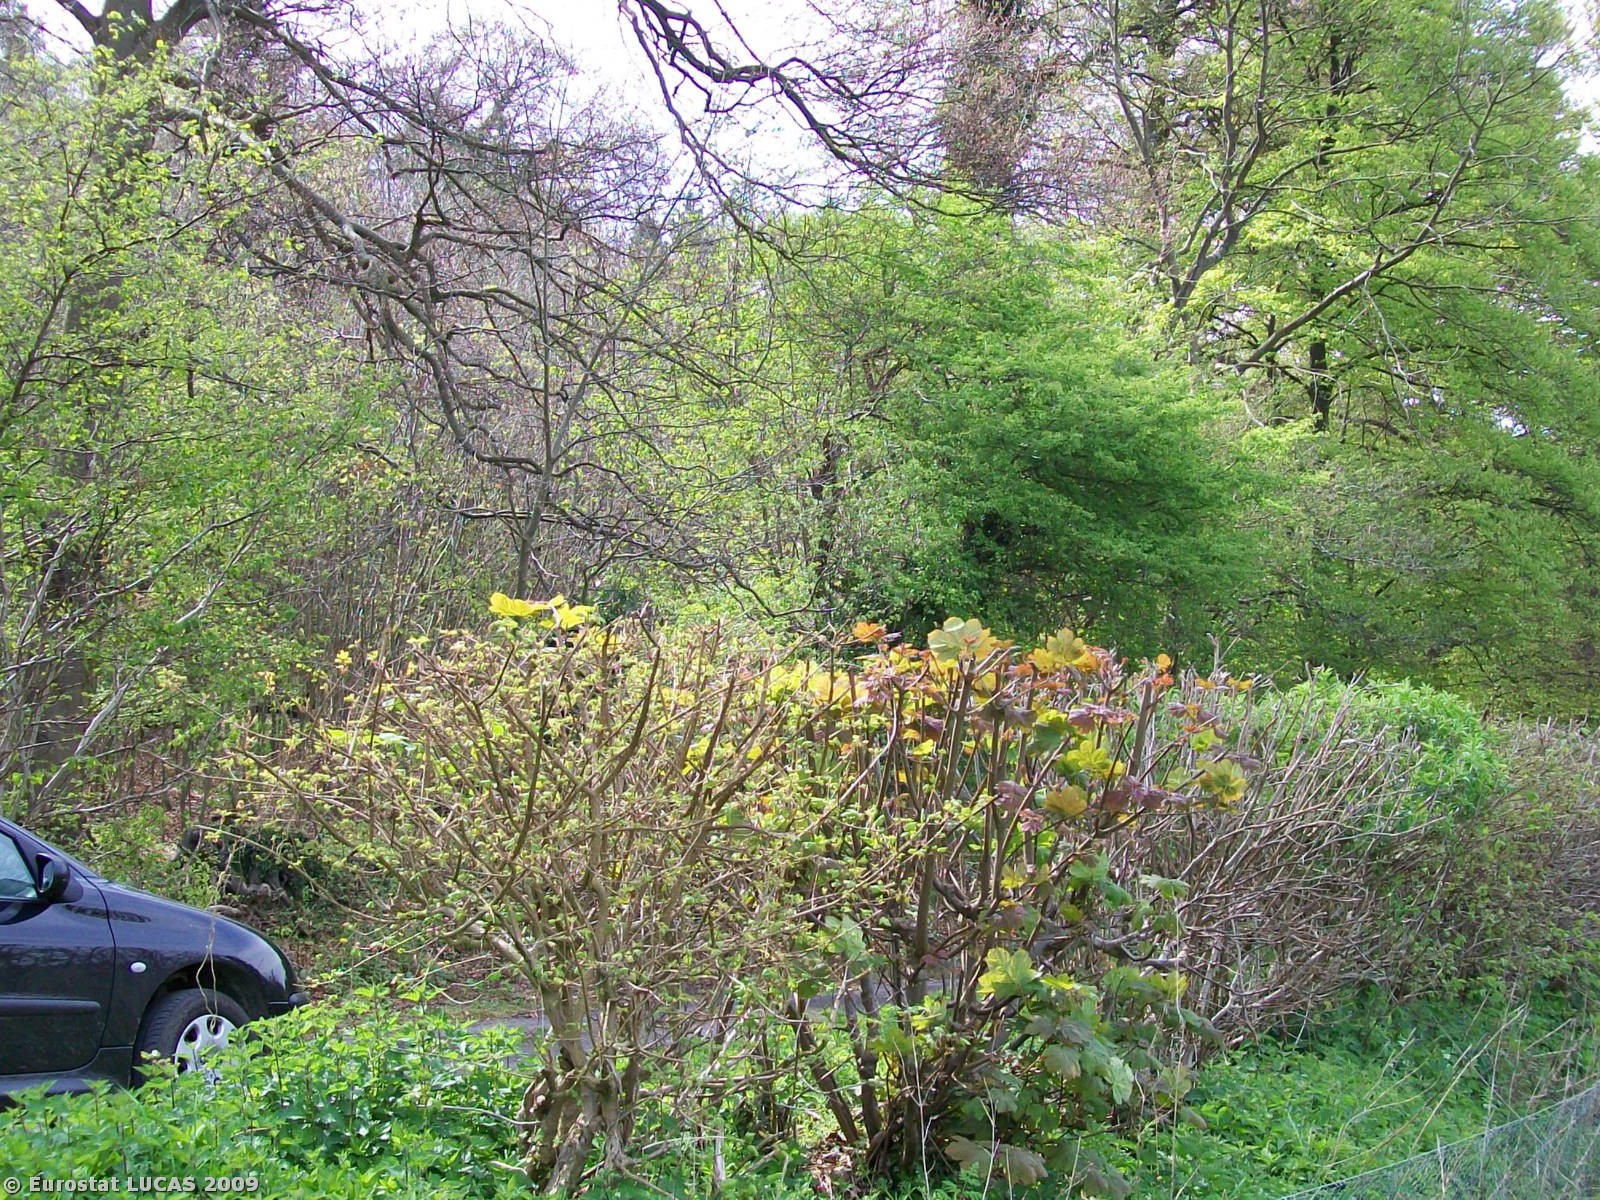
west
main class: Grassland
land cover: Grassland without tree/shrub cover
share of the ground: > 75 %
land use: Agriculture (excluding fallow land and kitchen gardens)
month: April
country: GB
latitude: 51.5400
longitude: -0.7833
